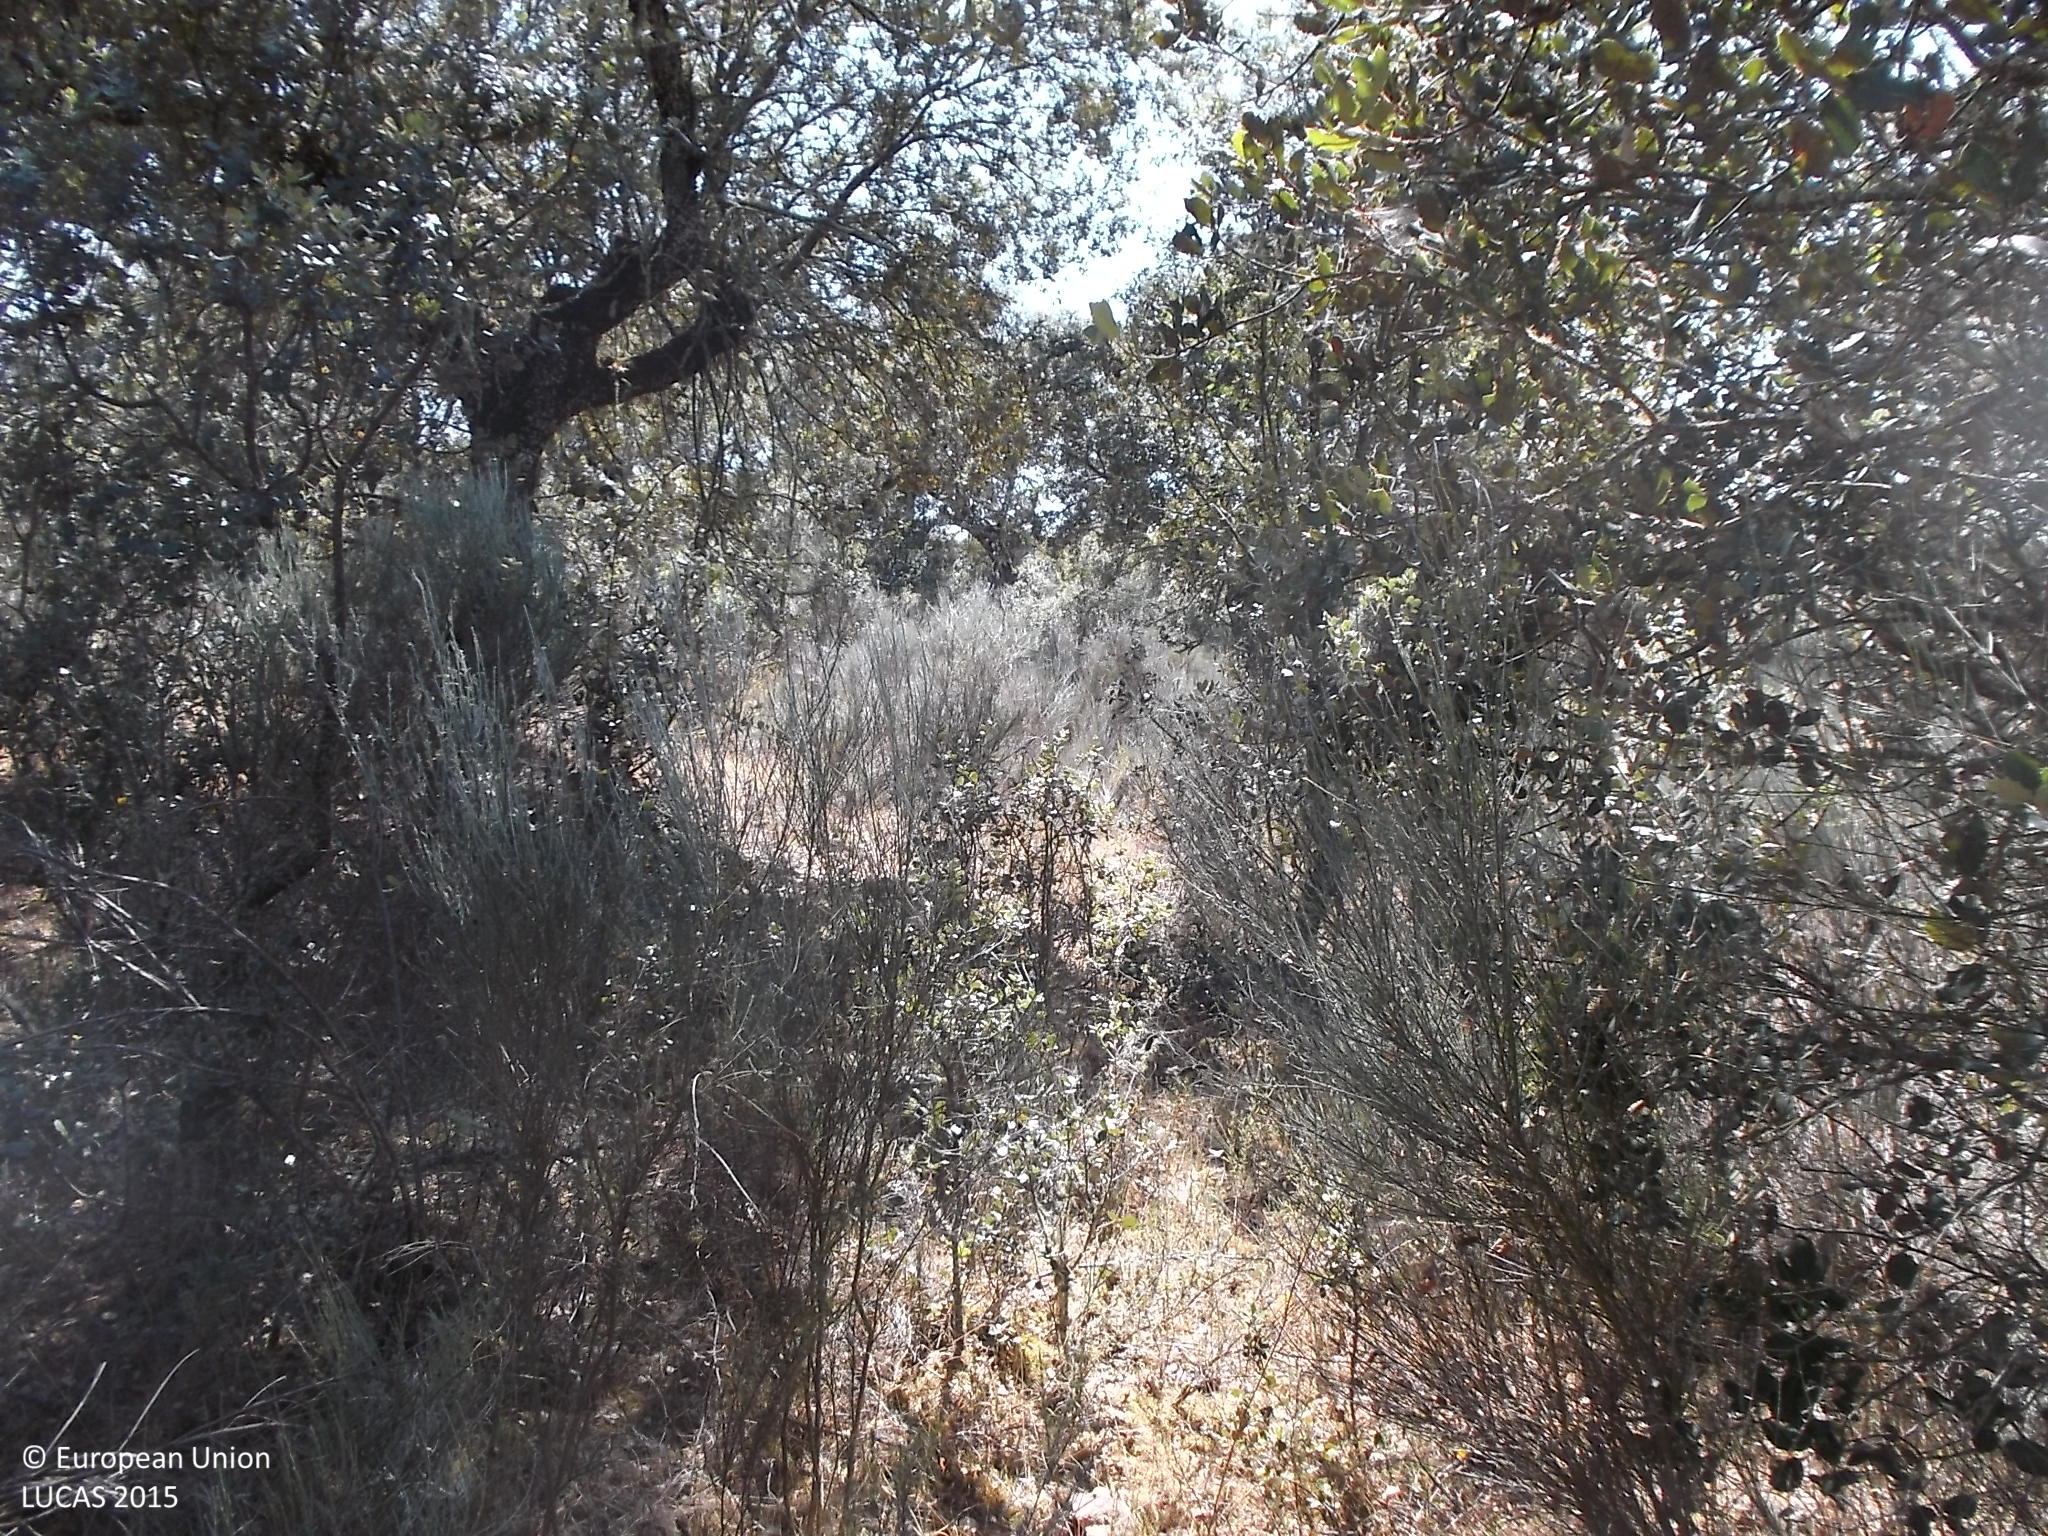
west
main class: Woodland
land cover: Broadleaved woodland
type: broadleaved evergreen forest
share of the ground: 50 - 75 %
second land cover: Shrubland without tree cover
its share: 50 - 75 %
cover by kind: broadleaved forest trees 60 %, shrubs 40 %
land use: Forestry
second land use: Agriculture (excluding fallow land and kitchen gardens)
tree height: < 5 m
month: July
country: ES
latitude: 40.7269
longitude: -6.7796
